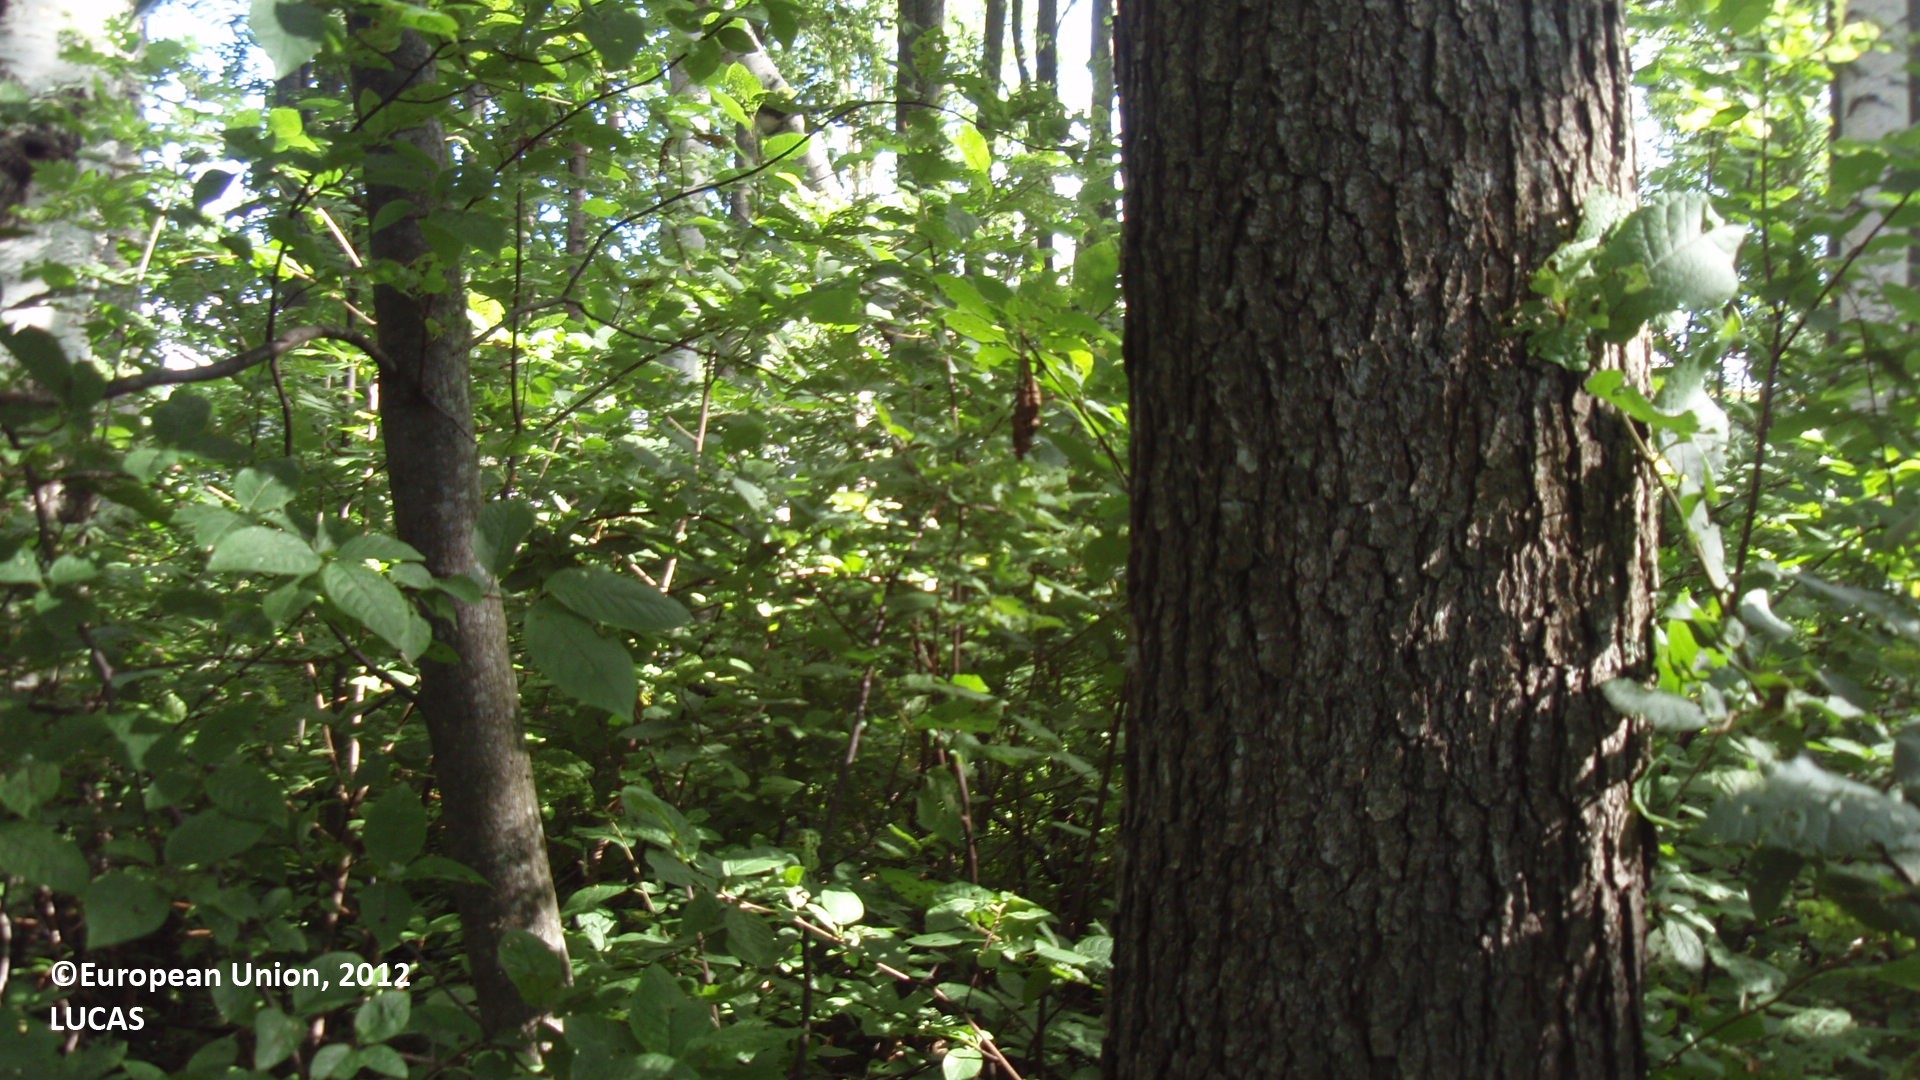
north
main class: Woodland
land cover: Broadleaved woodland
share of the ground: 50 - 75 %
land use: Forestry
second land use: Amenities, museums, leisure
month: July
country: FI
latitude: 61.2320
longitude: 28.8739
